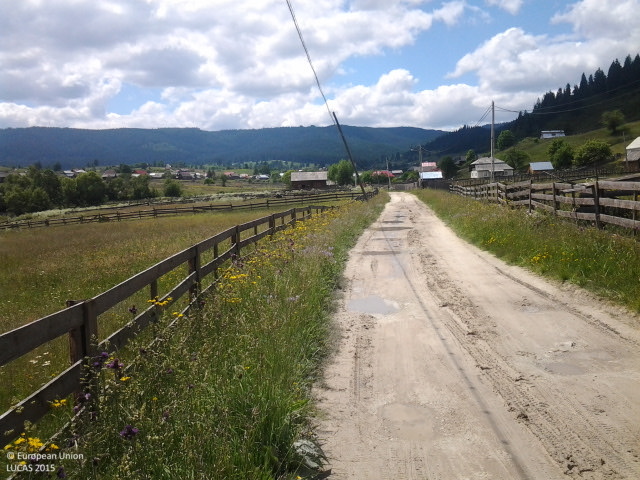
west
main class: Grassland
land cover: Grassland without tree/shrub cover
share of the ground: > 75 %
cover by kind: herbaceous plants 100 %
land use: Agriculture (excluding fallow land and kitchen gardens)
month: June
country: RO
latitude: 47.0666
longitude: 25.4790
